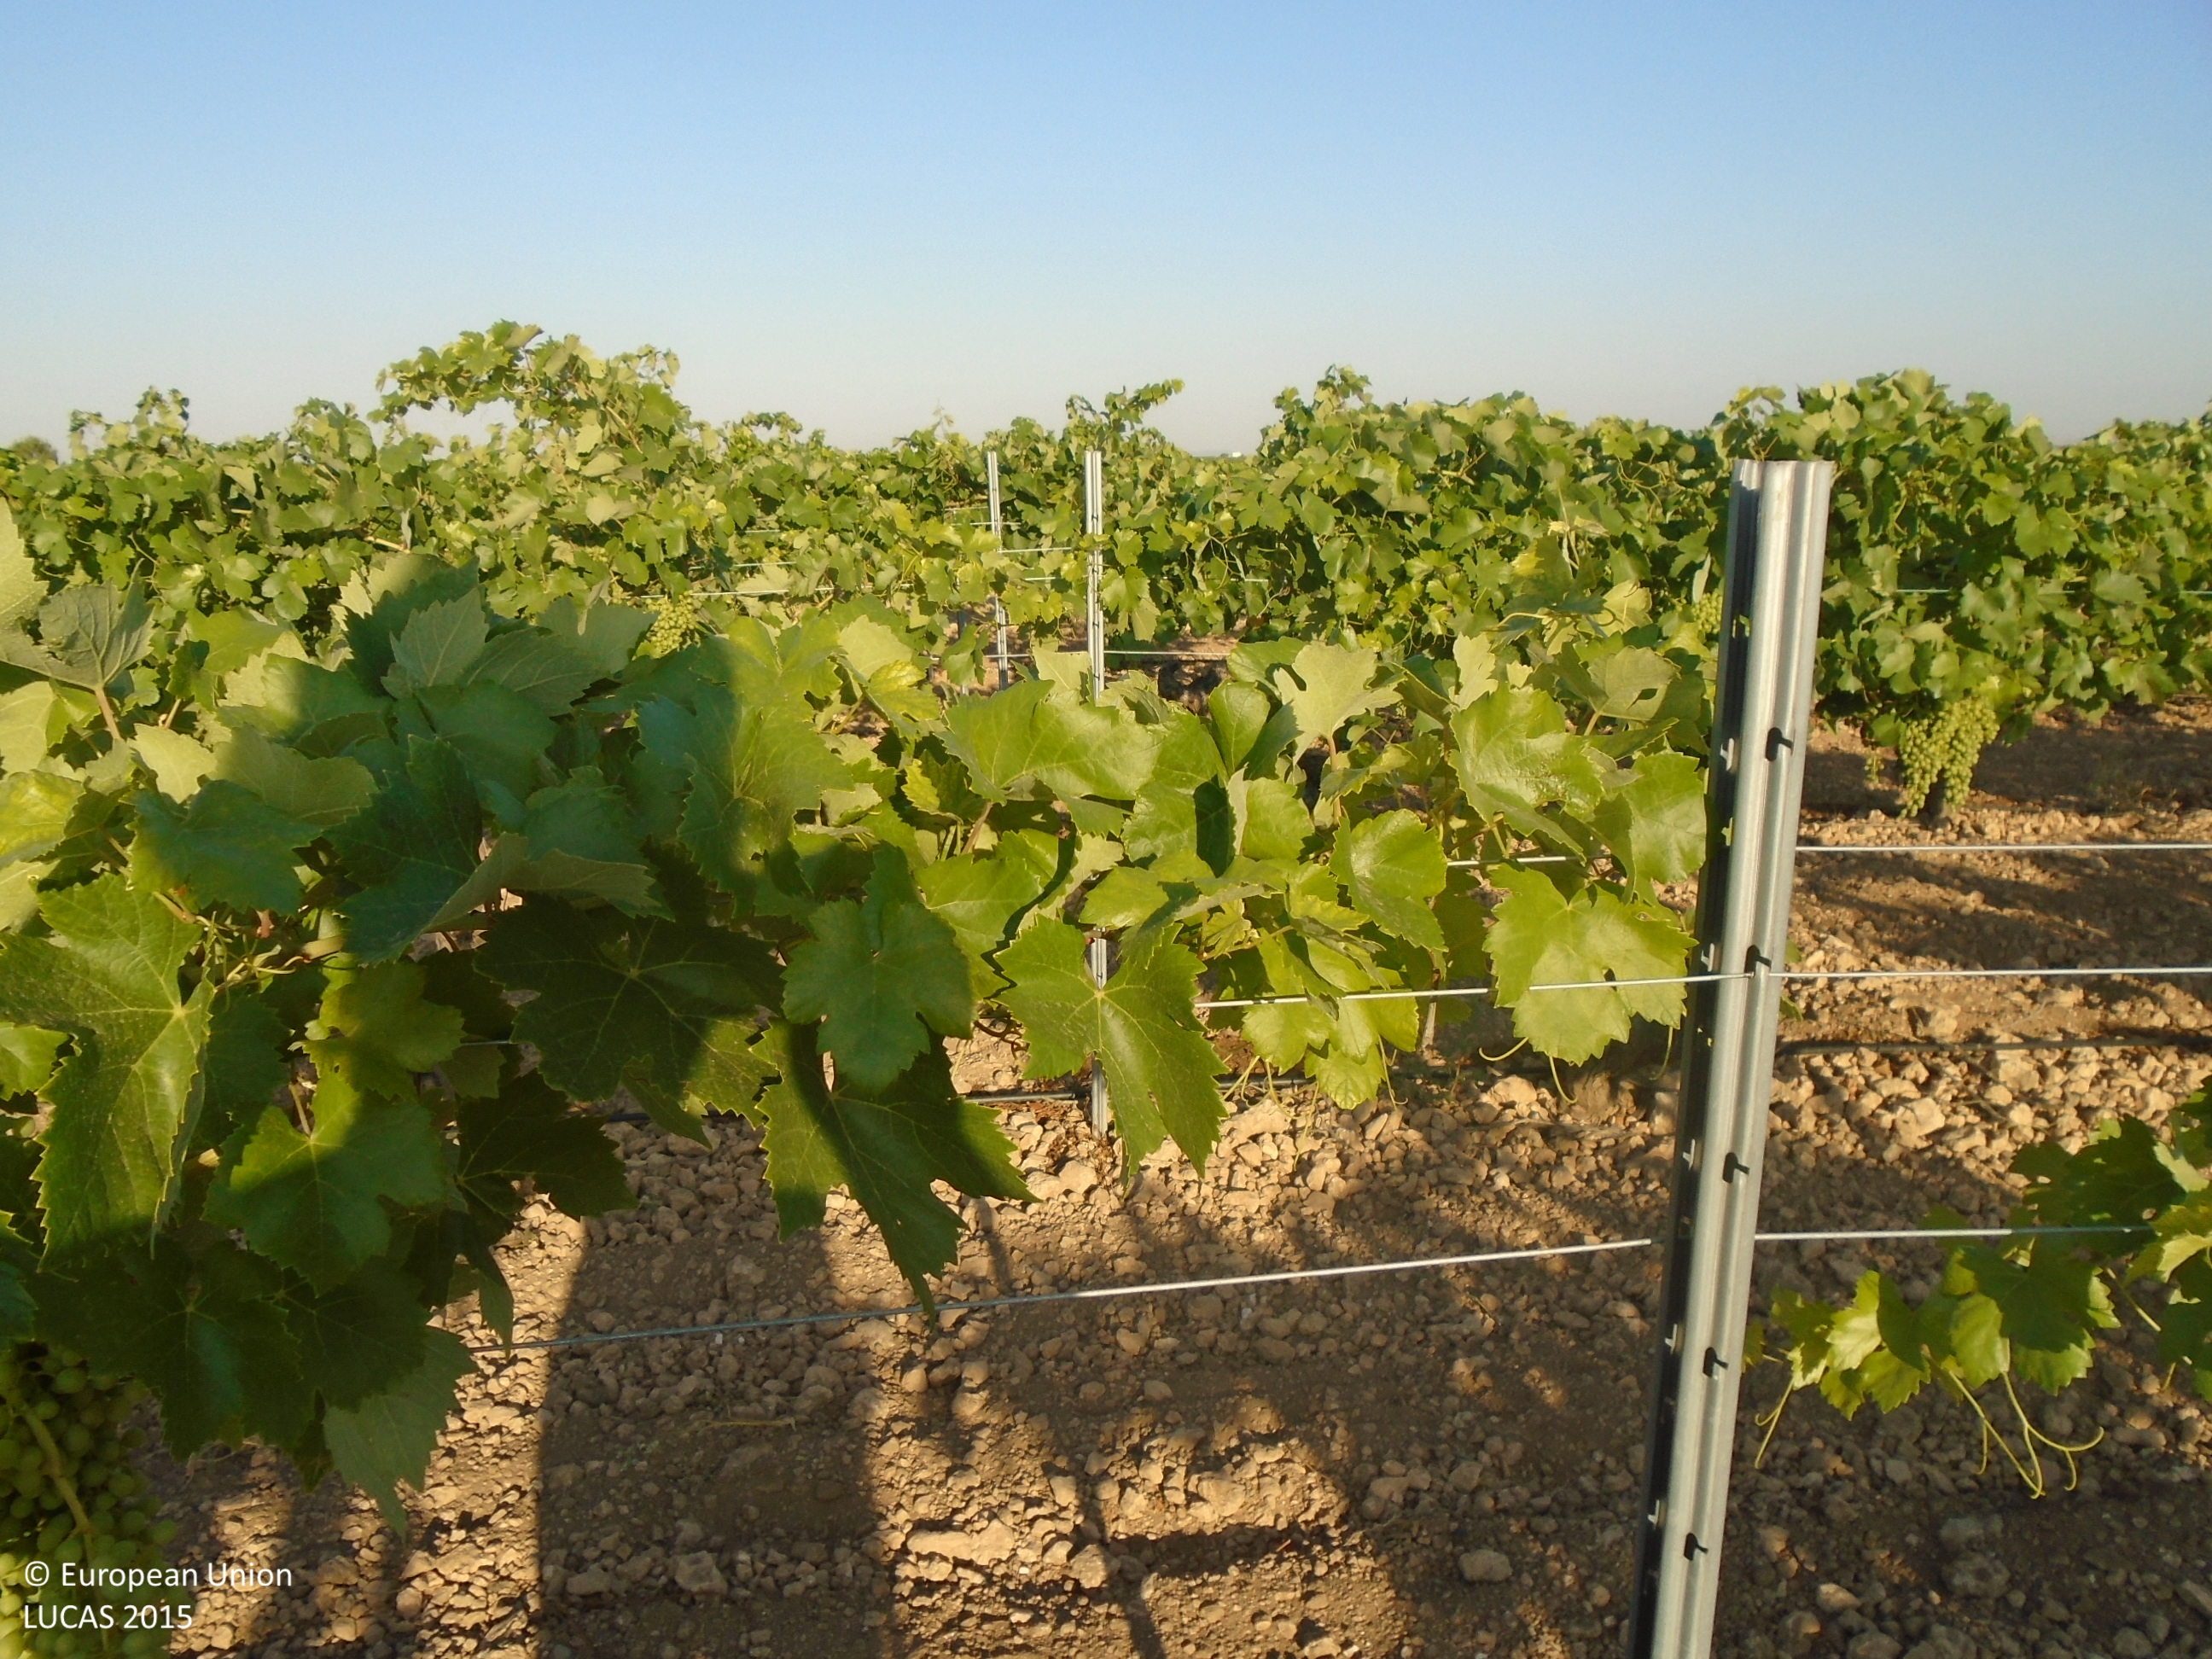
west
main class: Cropland
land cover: Vineyards
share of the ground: 10 - 25 %
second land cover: Other bare soil
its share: > 75 %
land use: Agriculture (excluding fallow land and kitchen gardens)
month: June
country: ES
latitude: 39.1484
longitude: -3.6149
